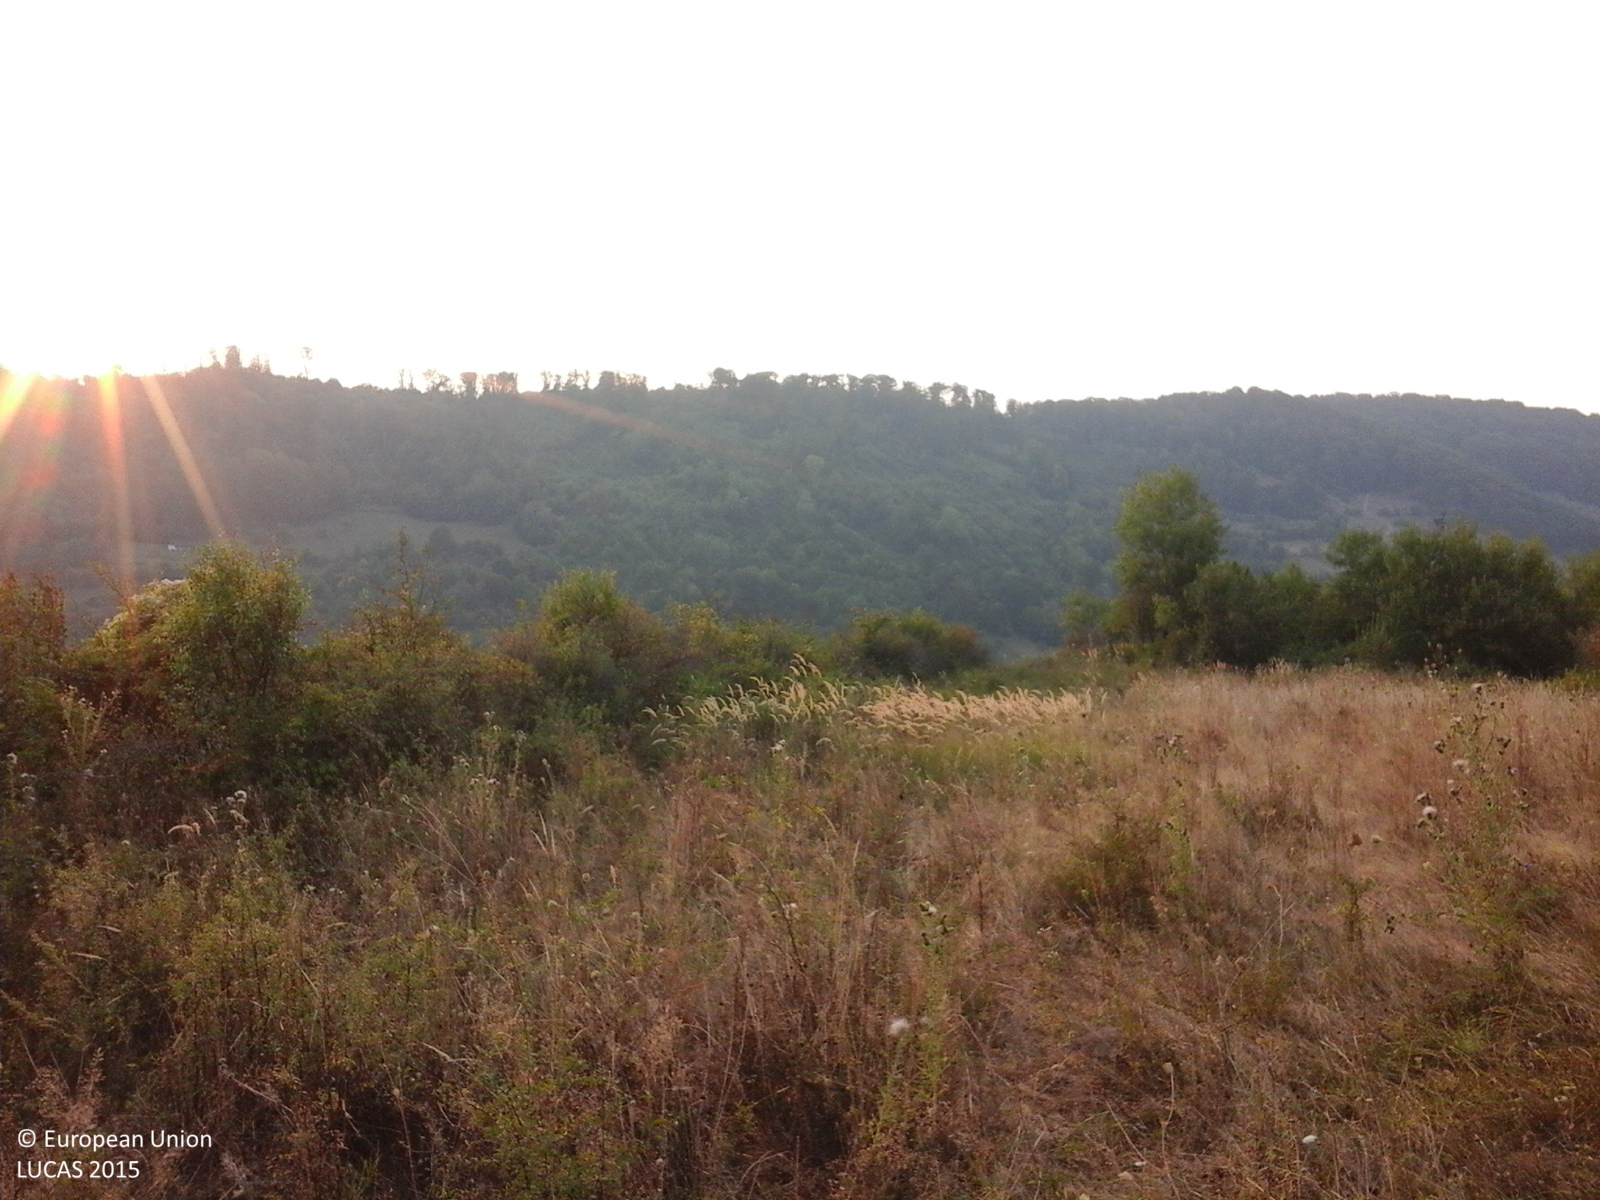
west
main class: Grassland
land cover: Spontaneously vegetated surfaces
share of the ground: > 75 %
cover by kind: herbaceous plants 100 %
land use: Fallow land
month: September
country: RO
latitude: 47.2885
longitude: 24.2750
